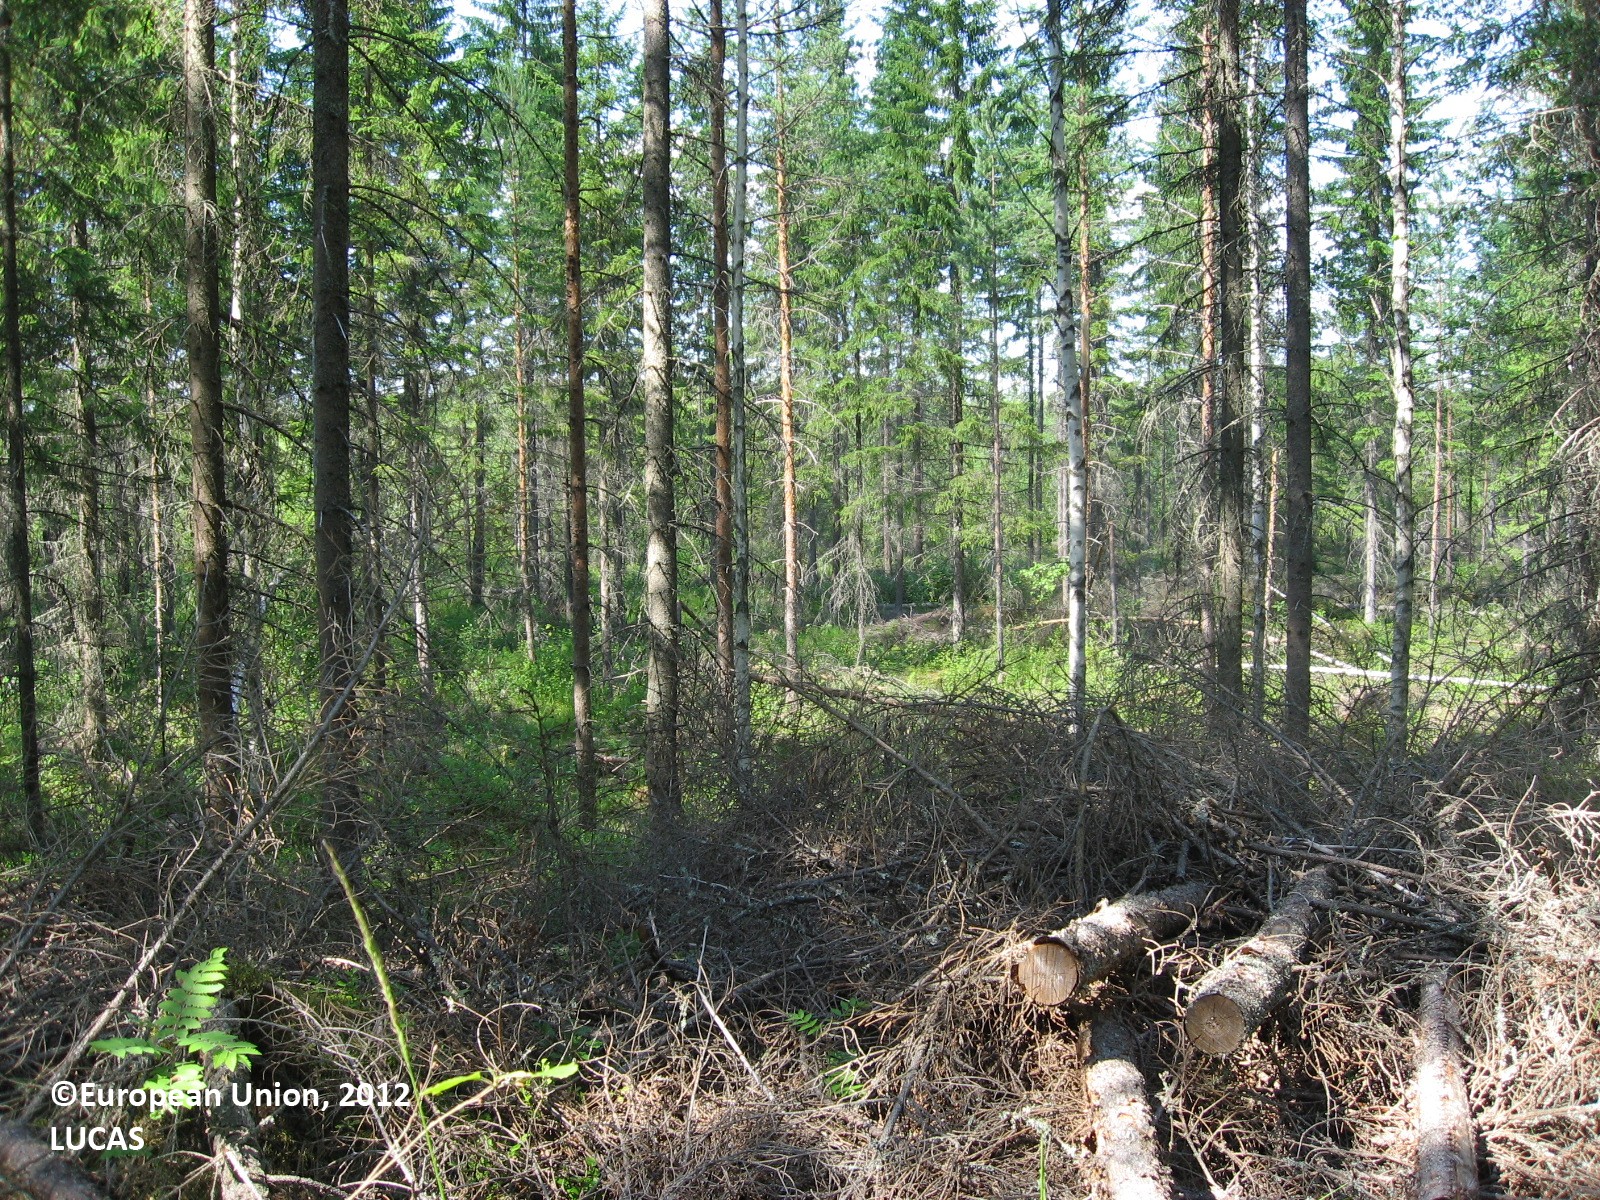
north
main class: Woodland
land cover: Spruce dominated coniferous woodland
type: boreal forest
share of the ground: 50 - 75 %
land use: Forestry
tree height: > 5 m
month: July
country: FI
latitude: 61.0878
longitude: 26.4481
